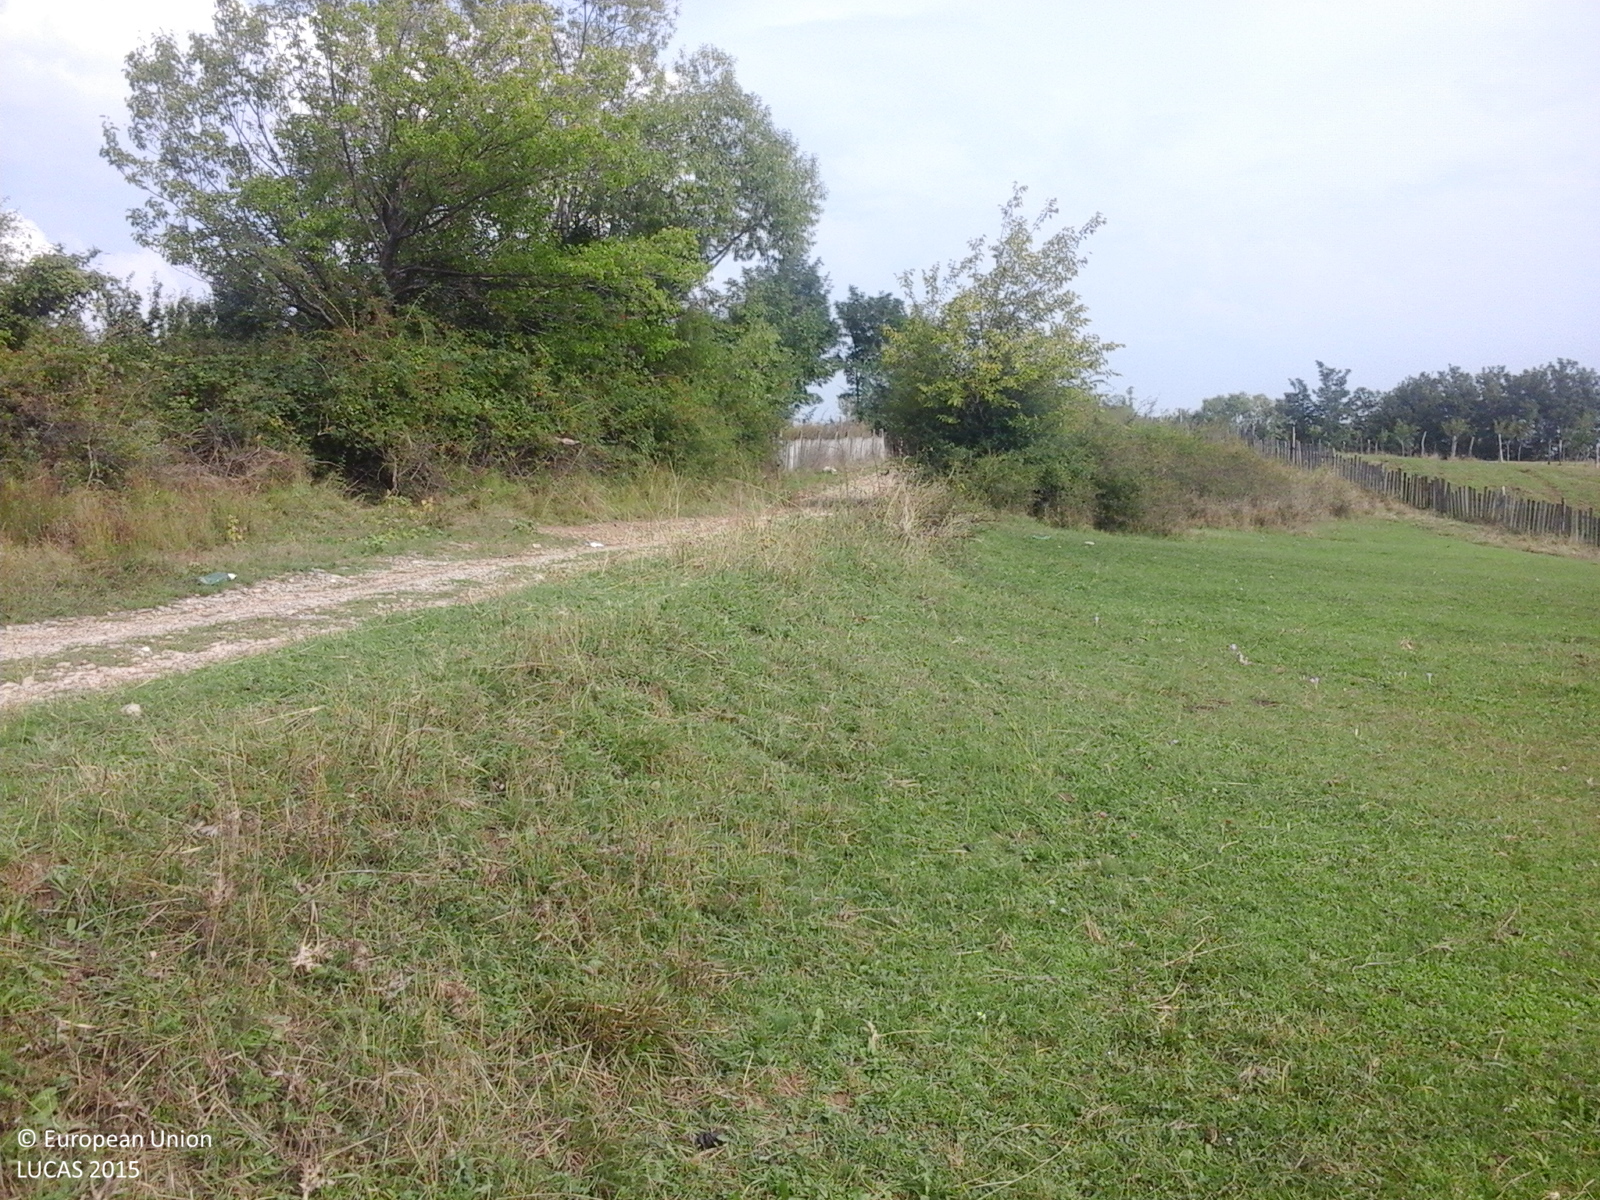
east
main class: Grassland
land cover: Grassland without tree/shrub cover
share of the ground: > 75 %
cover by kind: herbaceous plants 100 %
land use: Agriculture (excluding fallow land and kitchen gardens)
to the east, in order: Grassland without tree/shrub cover; Tracks; Fences; Abandoned hedges; Grassland without tree/shrub cover; Fences; Grassland without tree/shrub cover; Fences; Other fruit trees and berries; Fences; Grassland without tree/shrub cover; Fences; Grassland without tree/shrub cover; Fences; Other fruit trees and berries; Artificial constructions in urban areas
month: September
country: RO
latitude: 45.1582
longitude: 23.2459
